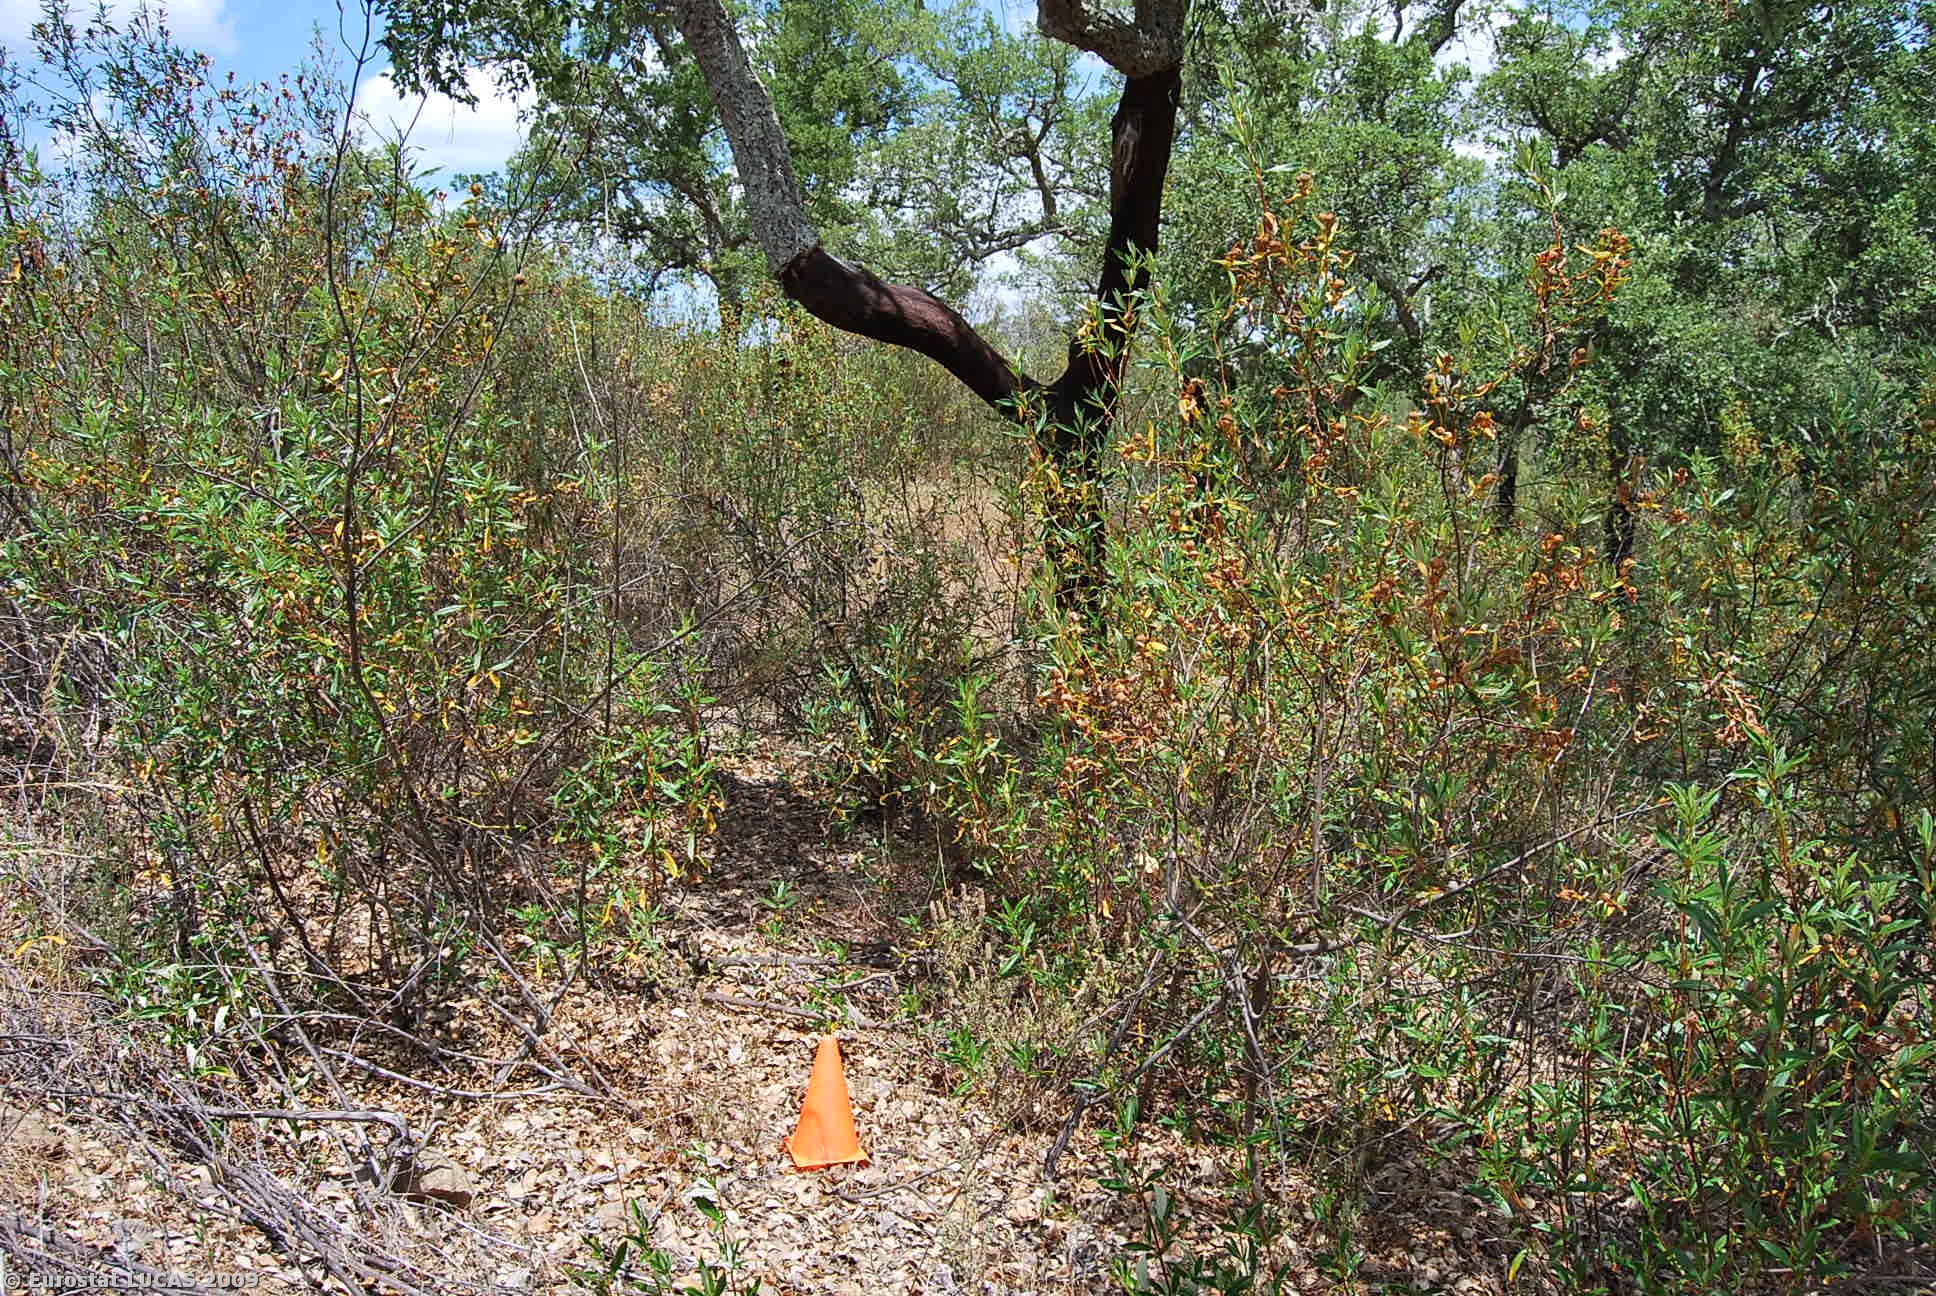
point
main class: Woodland
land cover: Broadleaved woodland
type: broadleaved evergreen forest
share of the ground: 10 - 25 %
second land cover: Shrubland with sparse tree cover
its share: 50 - 75 %
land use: Forestry
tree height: > 5 m
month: June
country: PT
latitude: 38.0082
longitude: -8.5988
